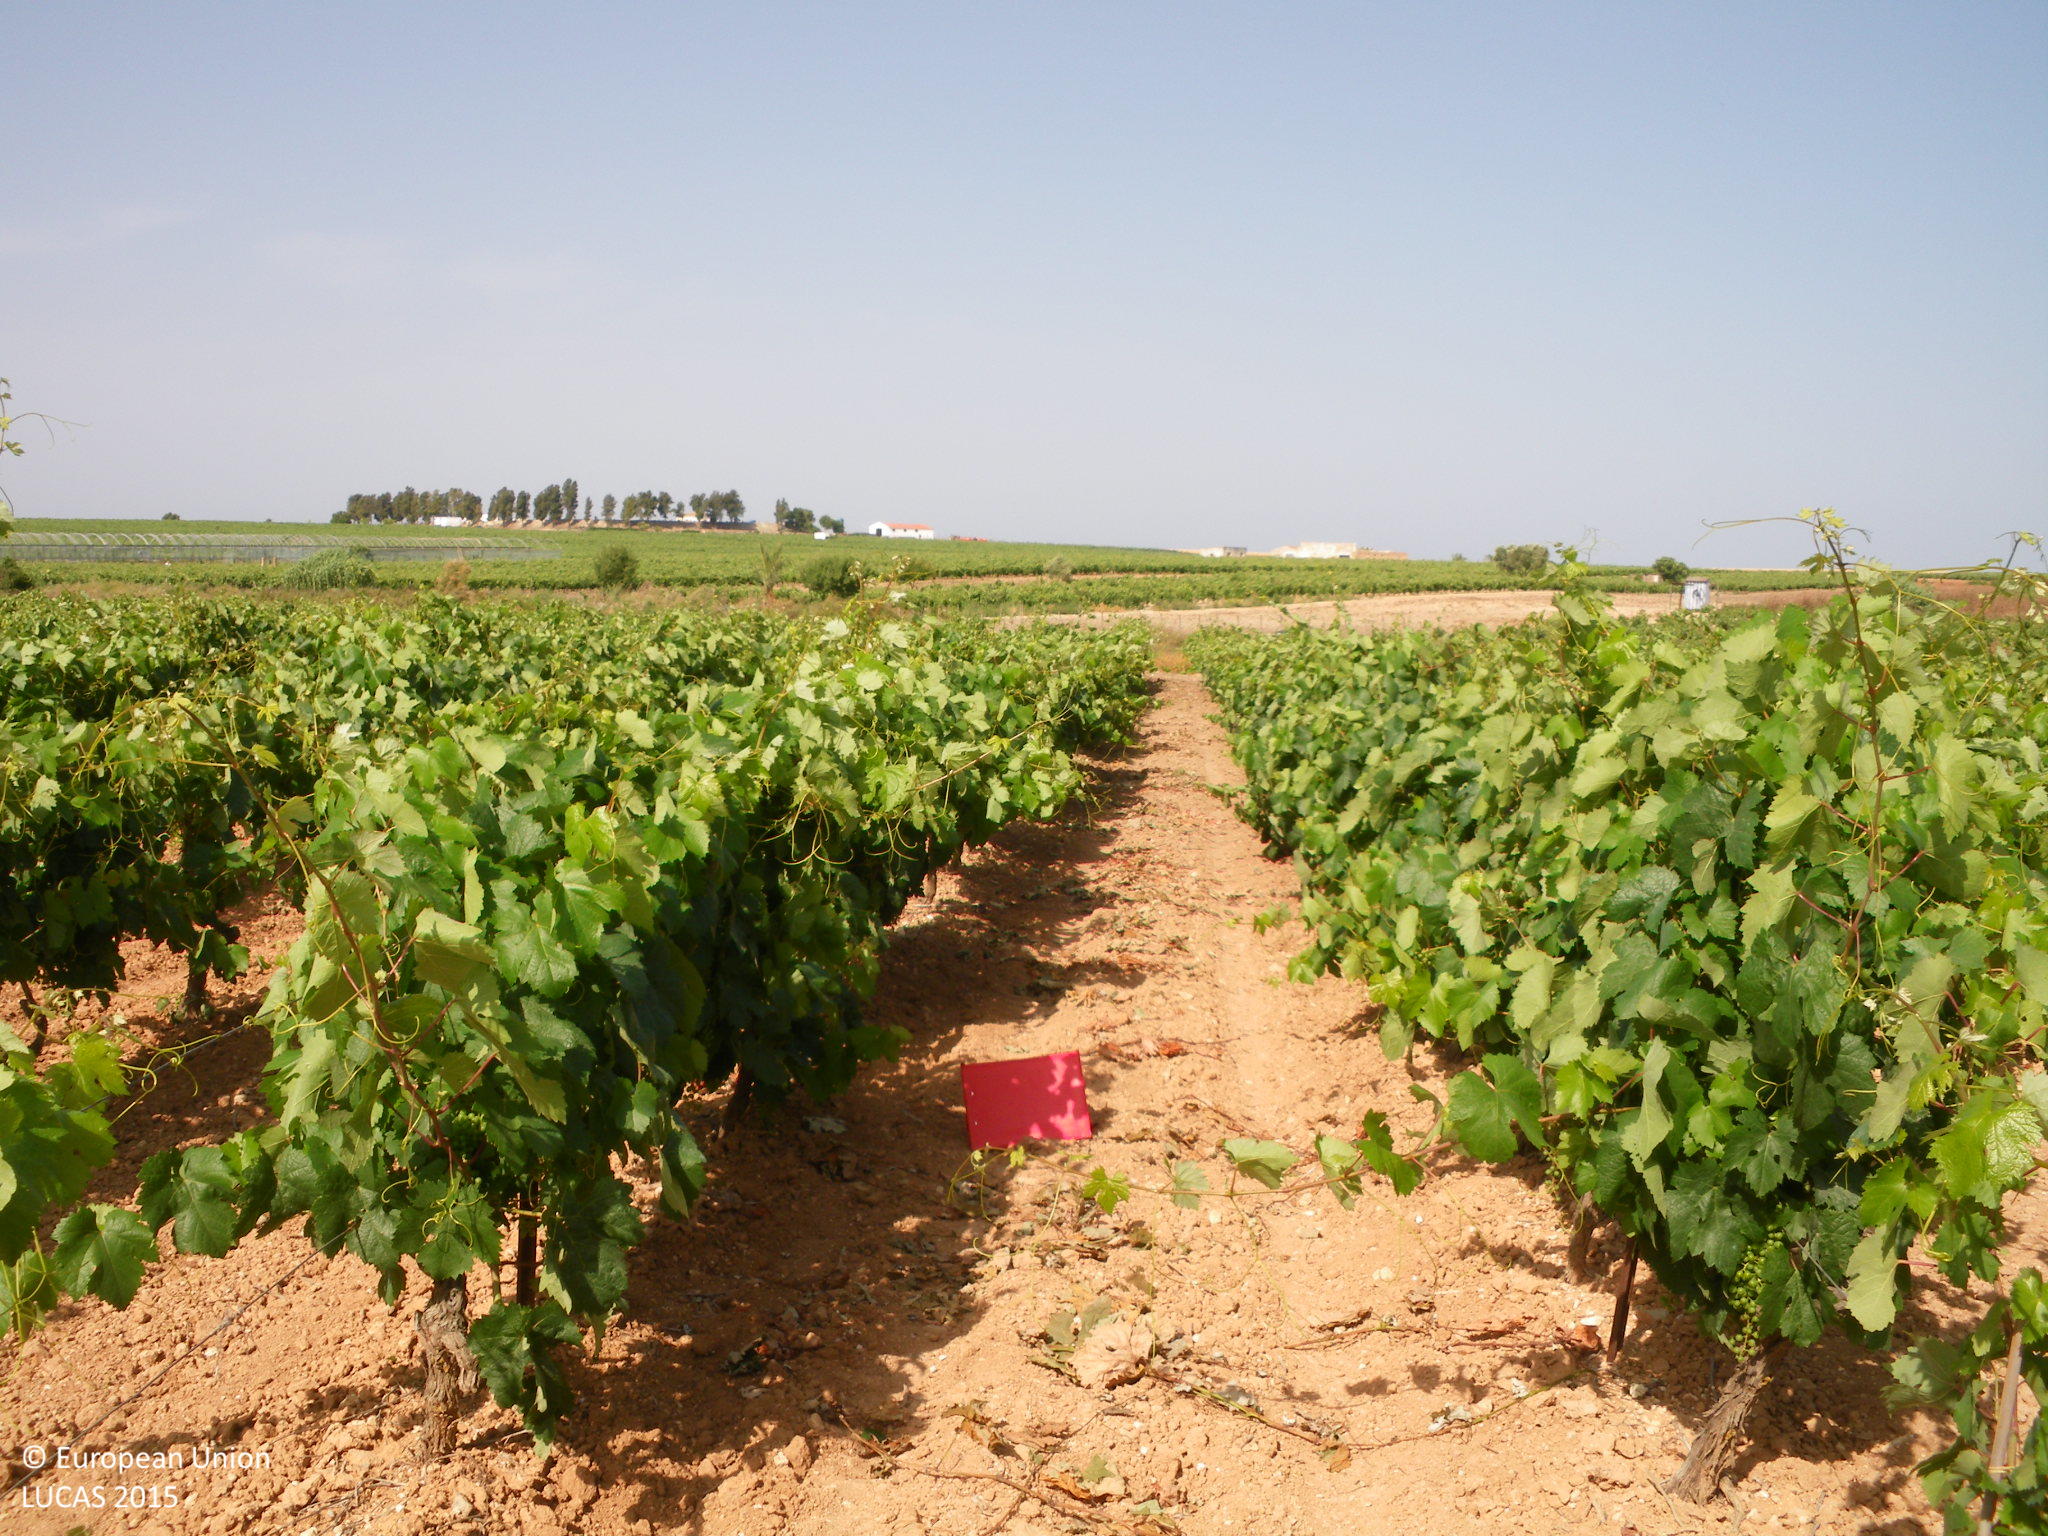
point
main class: Cropland
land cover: Vineyards
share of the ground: 25 - 50 %
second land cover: Other bare soil
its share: > 75 %
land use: Agriculture (excluding fallow land and kitchen gardens)
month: June
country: ES
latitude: 36.7275
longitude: -6.3533
